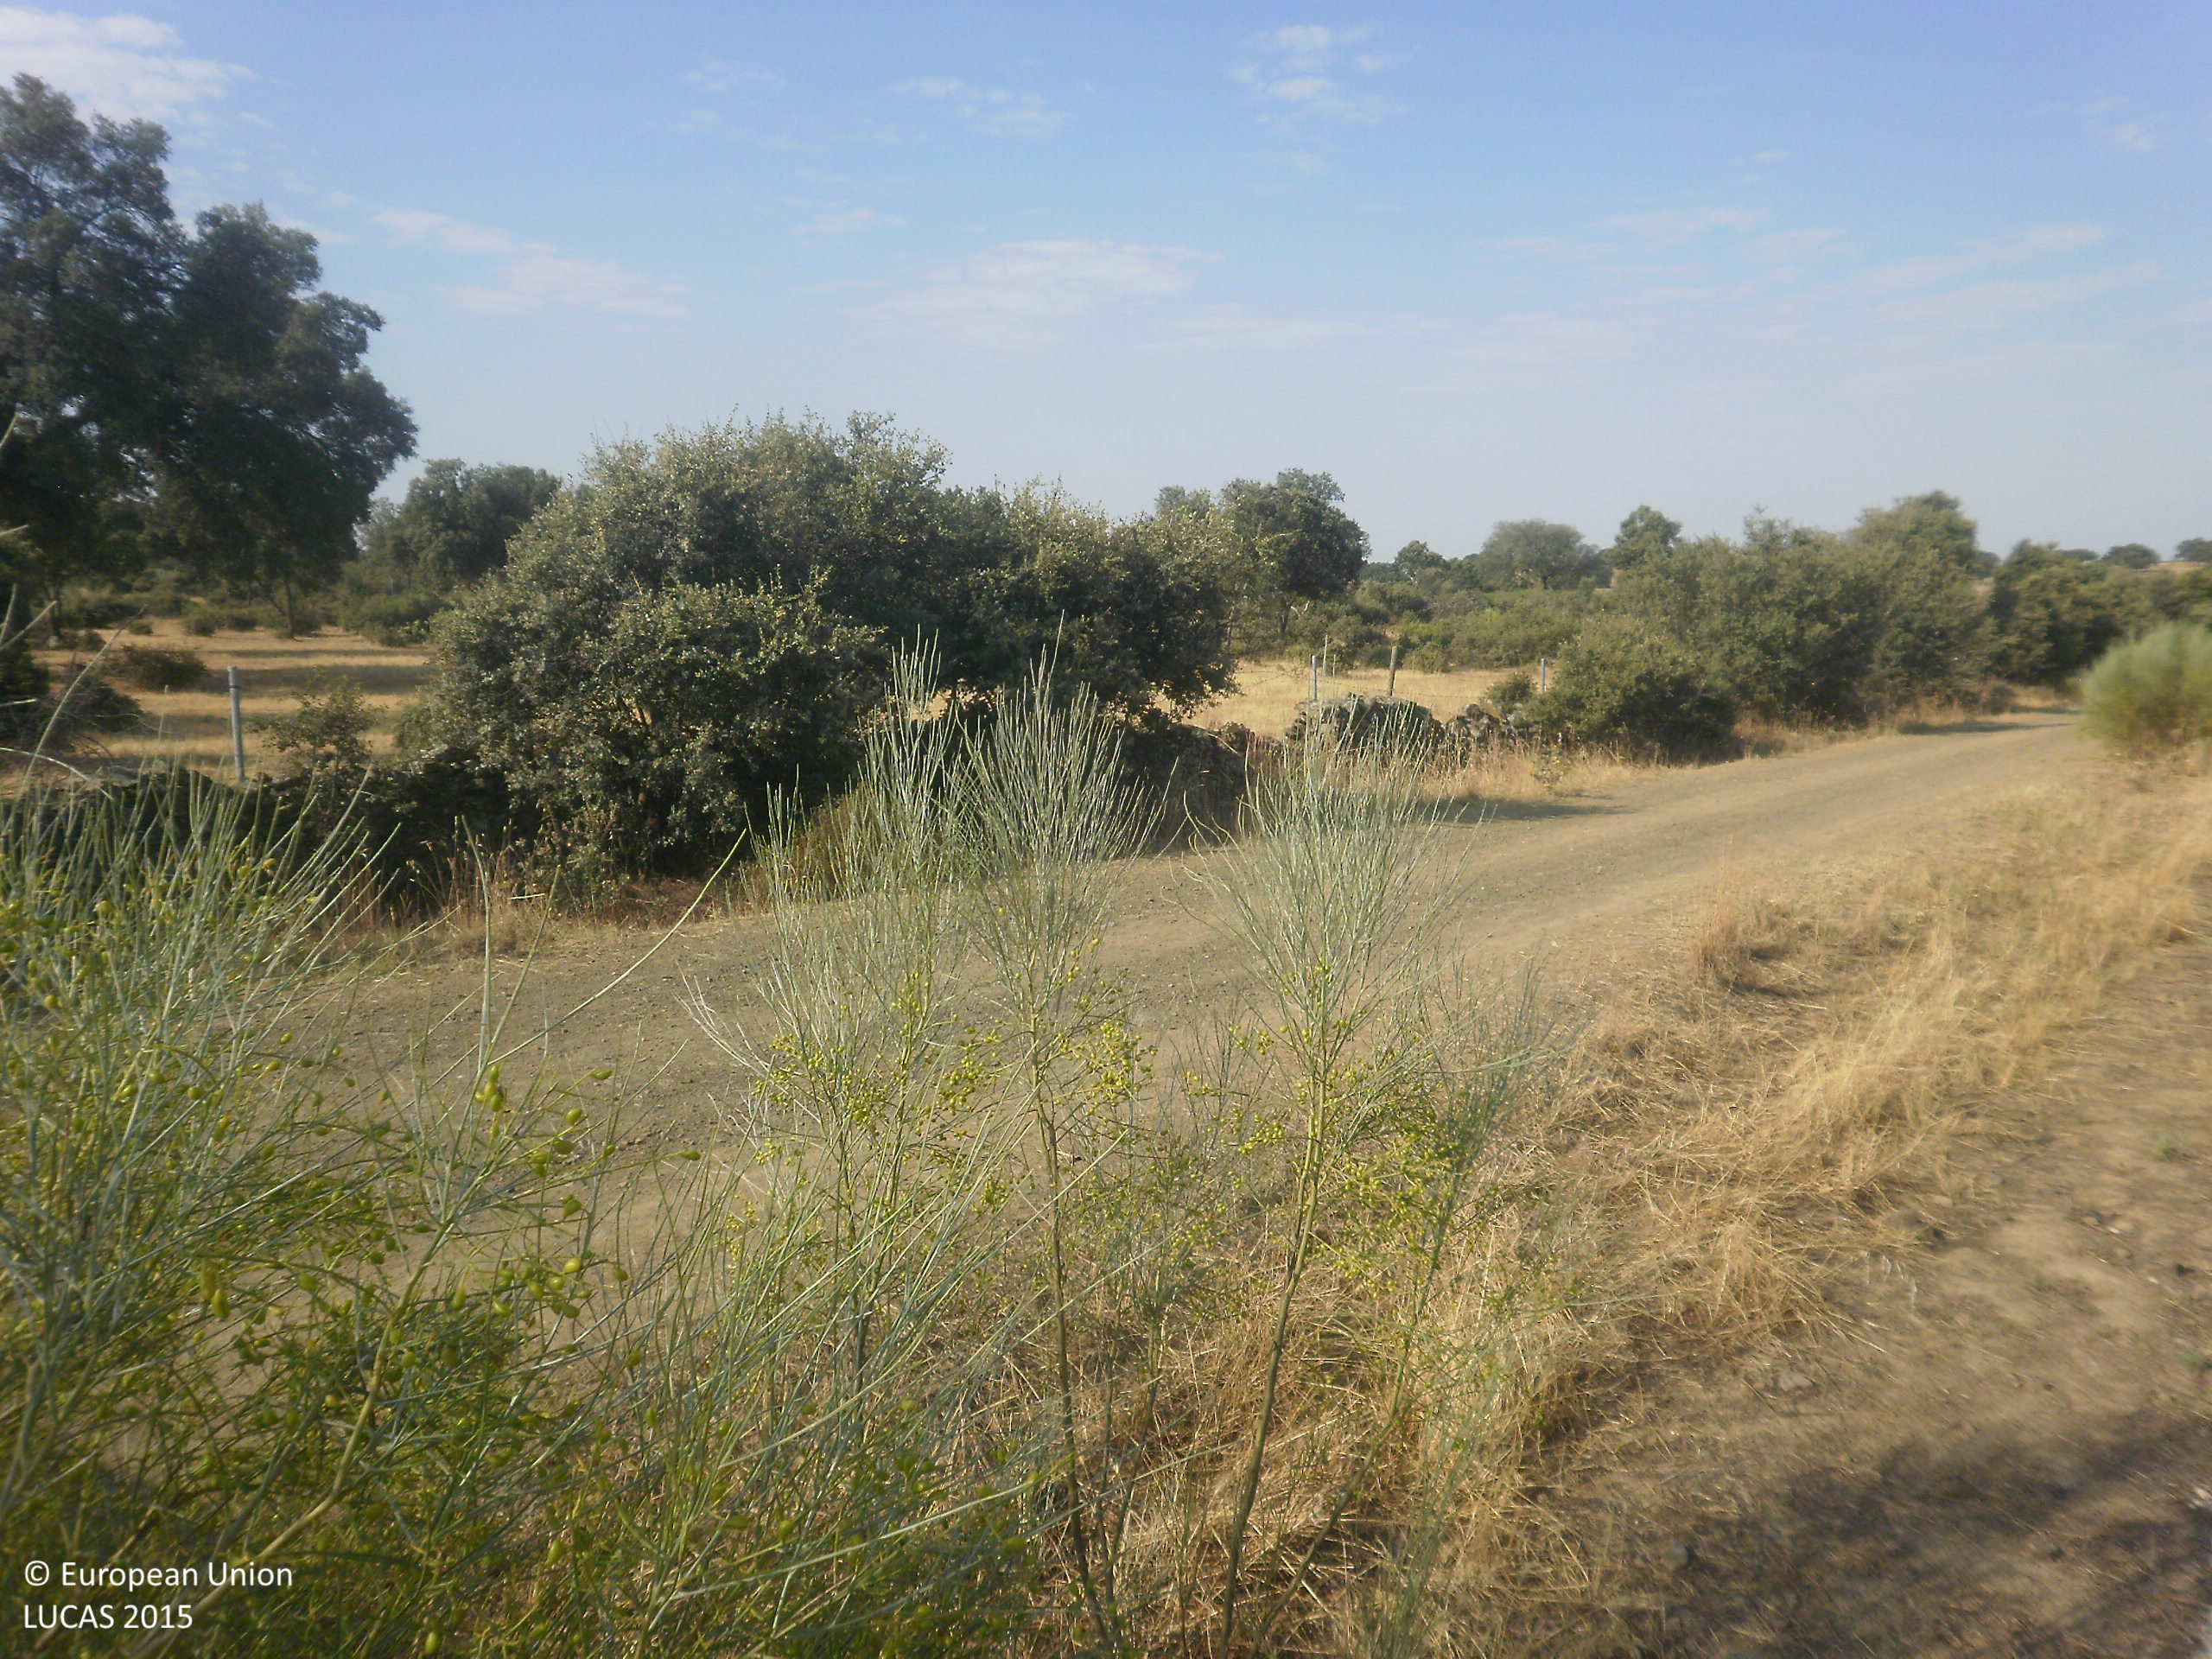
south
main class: Woodland
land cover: Broadleaved woodland
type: broadleaved evergreen forest
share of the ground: 10 - 25 %
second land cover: Grassland without tree/shrub cover
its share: 50 - 75 %
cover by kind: herbaceous plants 75 %, broadleaved forest trees 25 %
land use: Forestry
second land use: Agriculture (excluding fallow land and kitchen gardens)
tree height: > 5 m
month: June
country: ES
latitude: 39.2285
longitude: -5.8426
